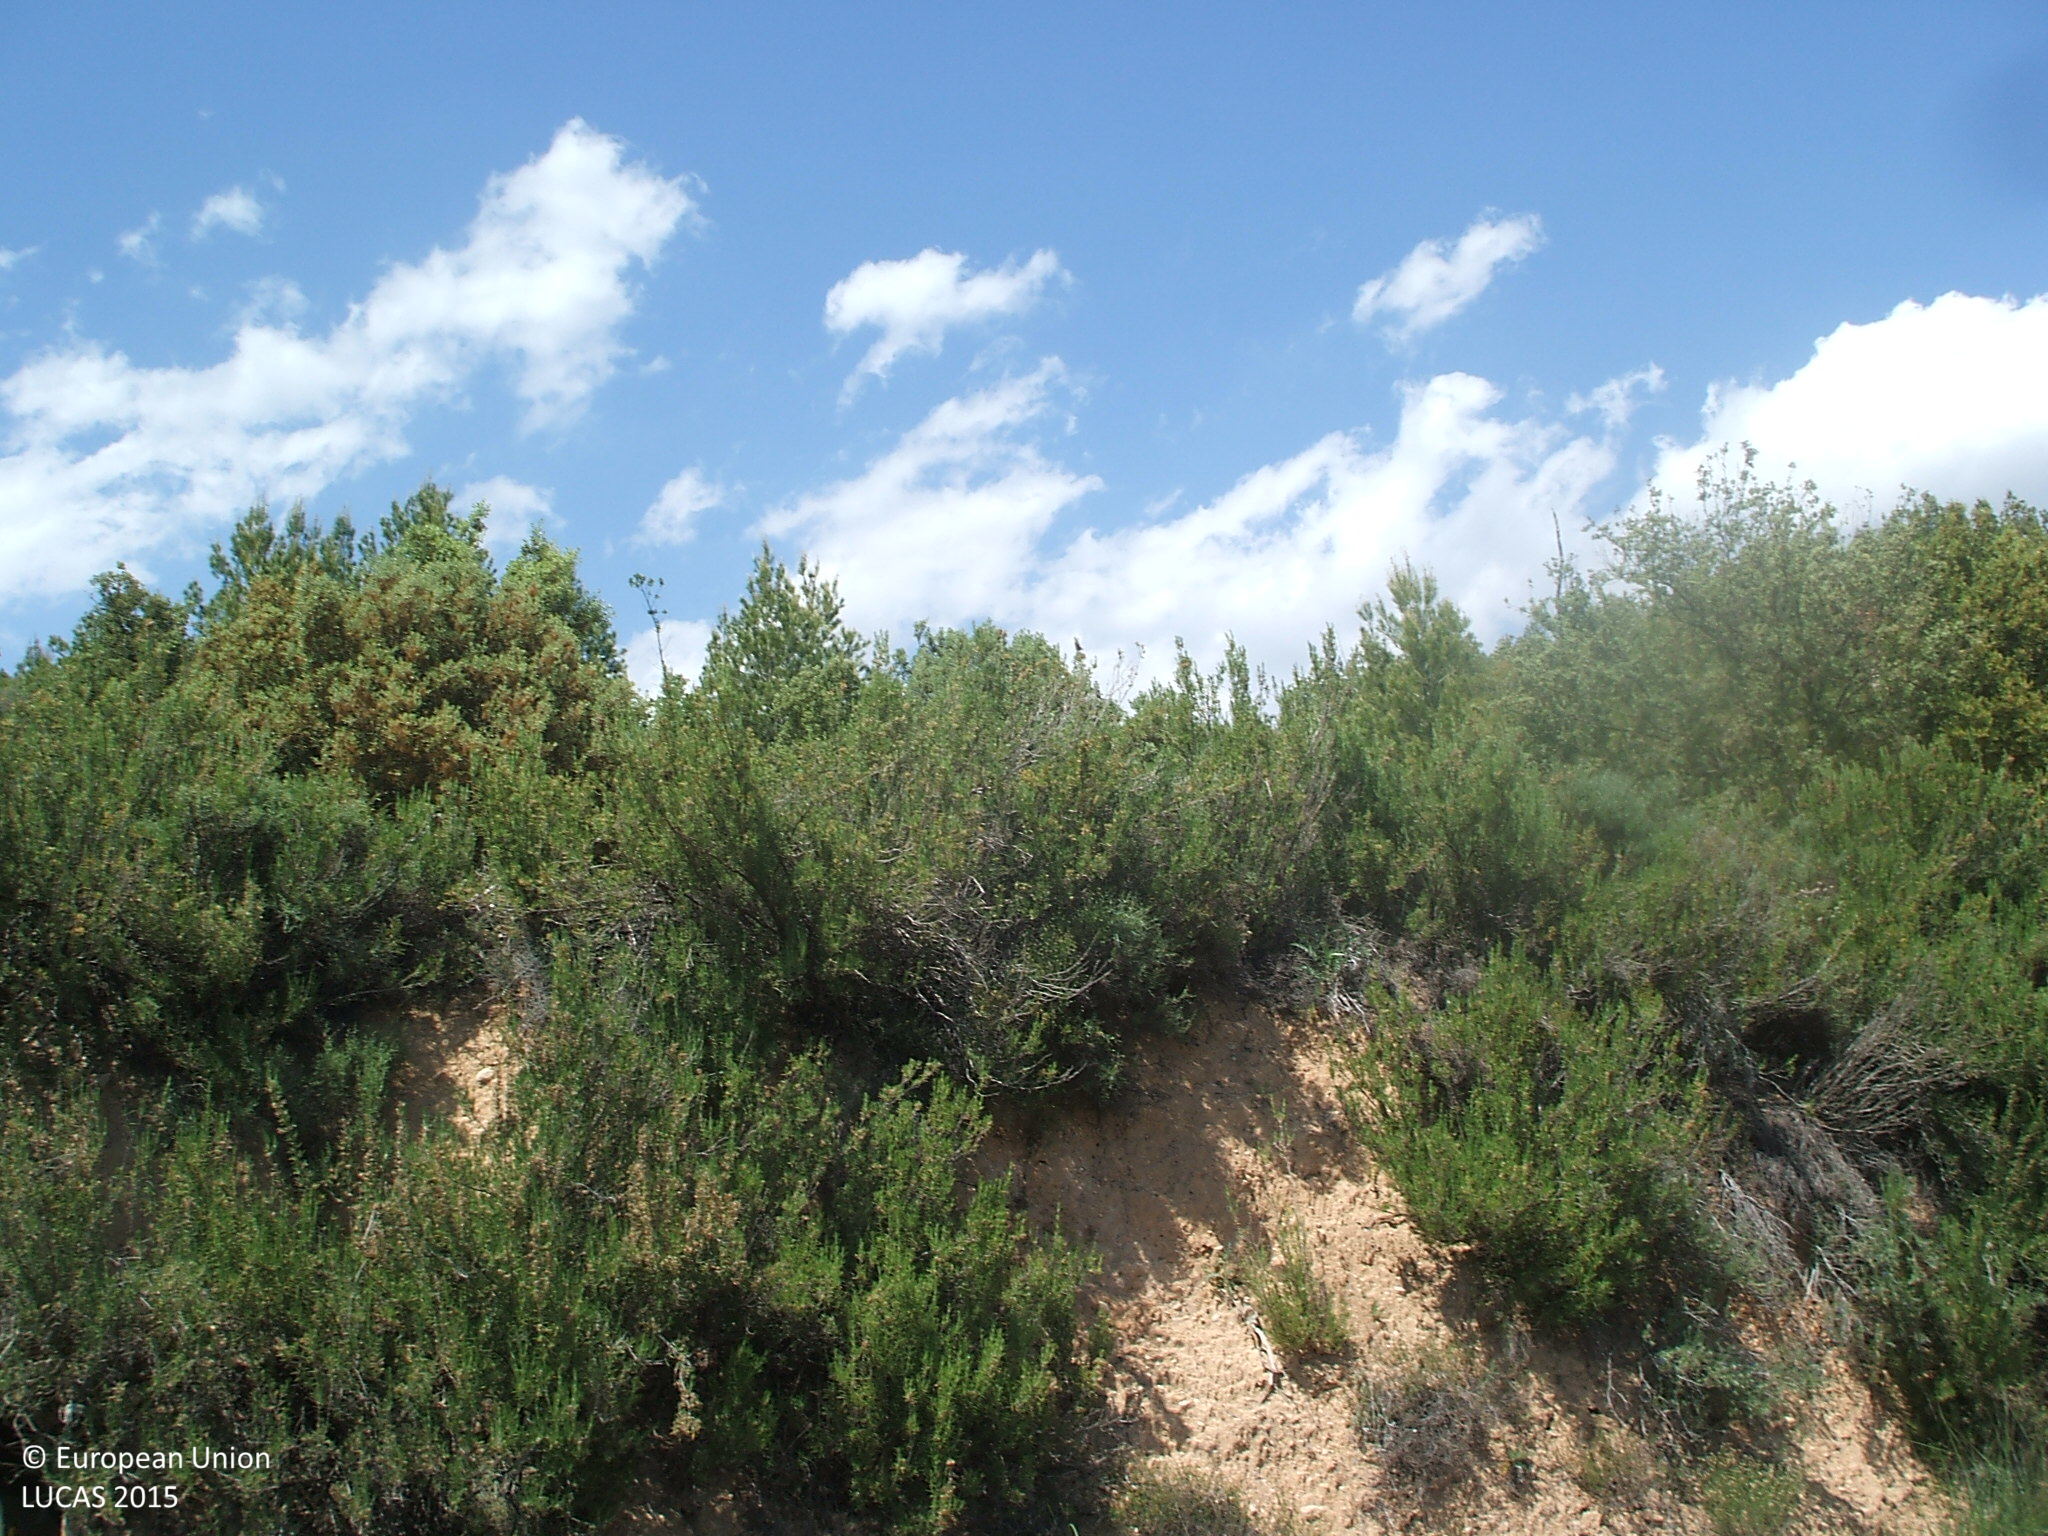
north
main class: Cropland
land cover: Oats
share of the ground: < 10 %
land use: Agriculture (excluding fallow land and kitchen gardens)
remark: Harvested field
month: May
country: ES
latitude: 40.7180
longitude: -0.2014
